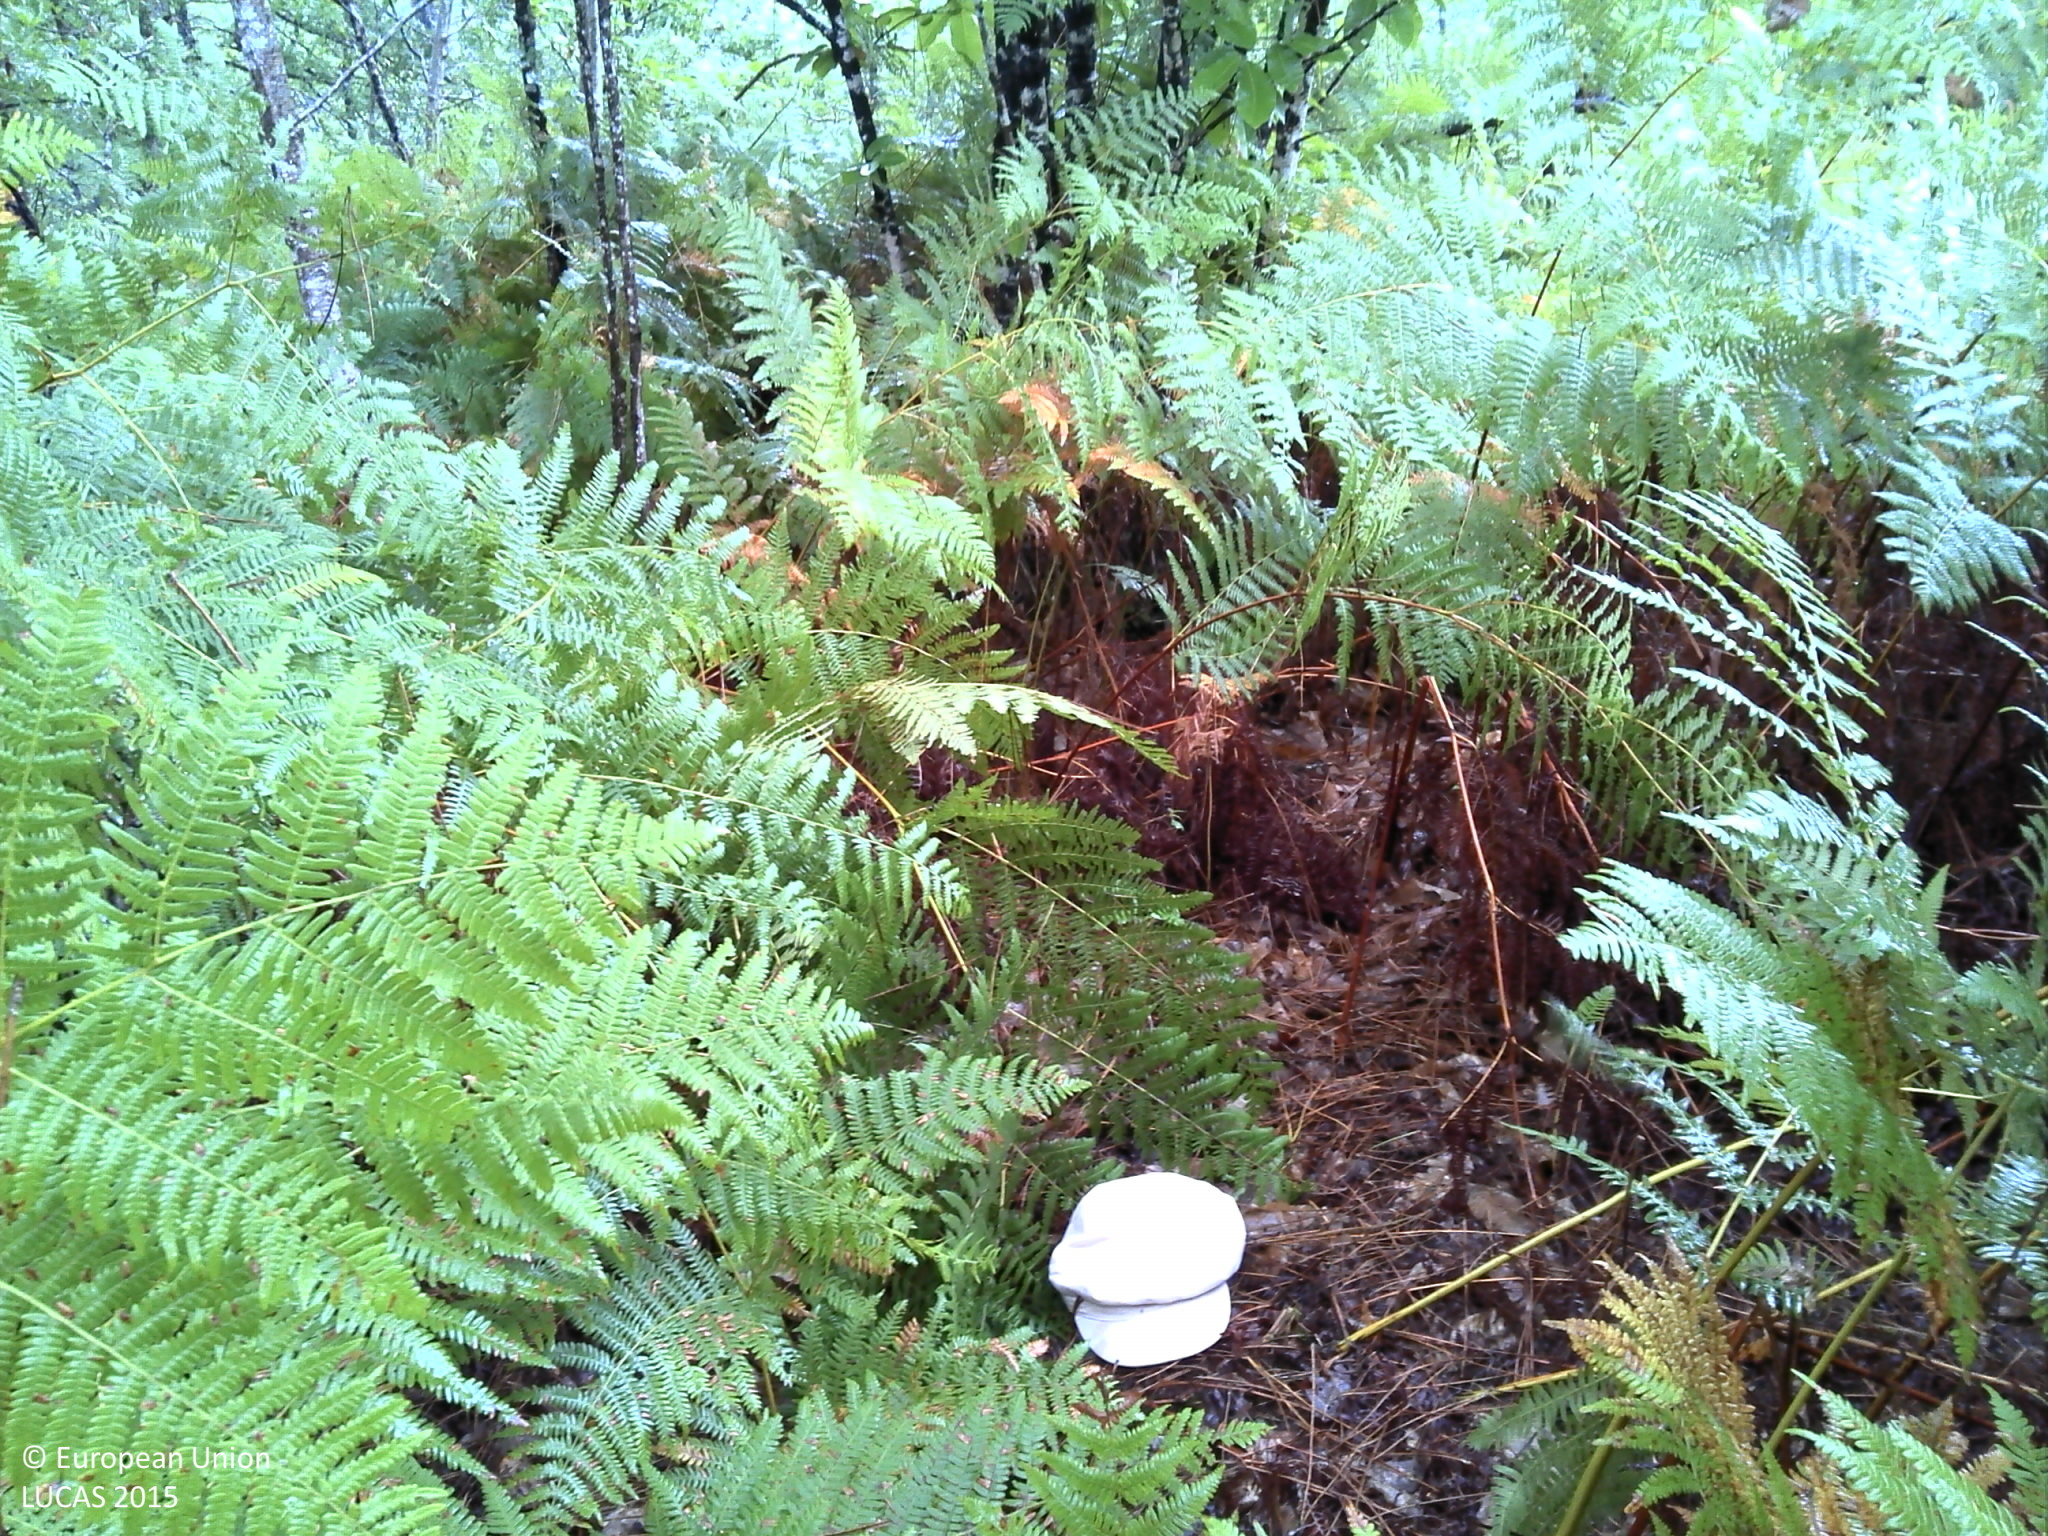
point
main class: Woodland
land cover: Pine dominated mixed woodland
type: coniferous forest of the mediterranean region
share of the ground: > 75 %
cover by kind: broadleaved forest trees 40 %, shrubs 30 %, coniferous forest trees 20 %, herbaceous plants 10 %
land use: Forestry
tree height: > 5 m
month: August
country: FR
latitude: 45.2105
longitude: -0.5503
